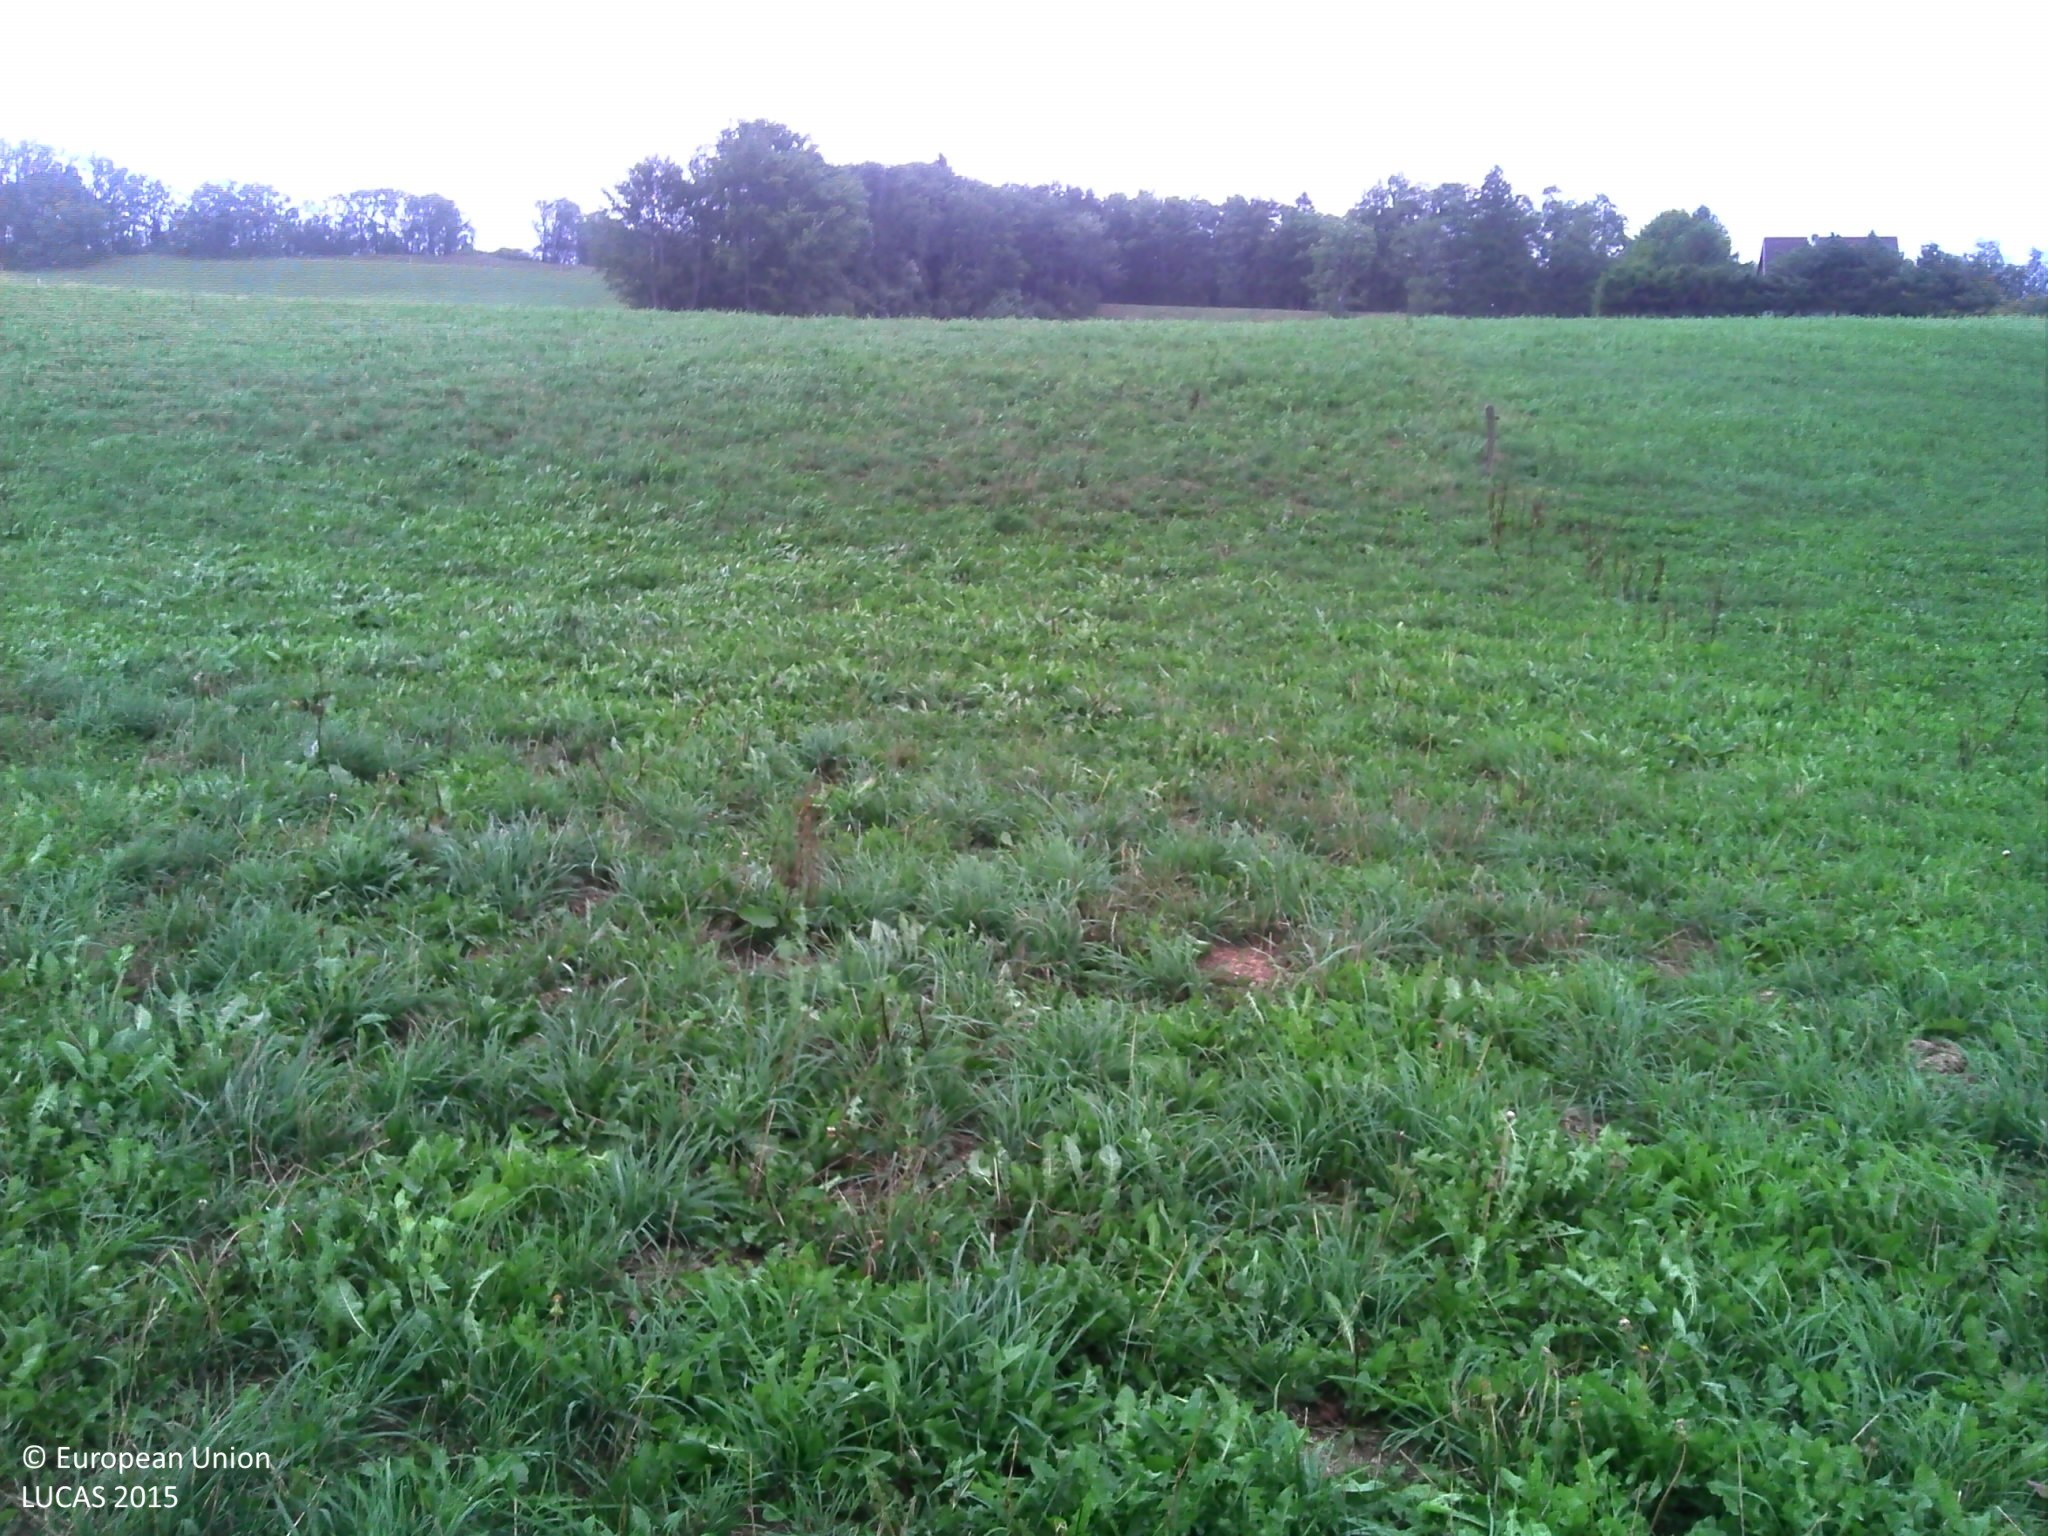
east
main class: Grassland
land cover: Grassland without tree/shrub cover
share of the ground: > 75 %
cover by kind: herbaceous plants 100 %
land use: Agriculture (excluding fallow land and kitchen gardens)
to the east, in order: Grassland without tree/shrub cover; Fences; Grassland without tree/shrub cover; Lines of trees; Paved roads, cycling and walking lanes; Broadleaved woodland
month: August
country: FR
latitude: 45.1798
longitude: 5.6405
